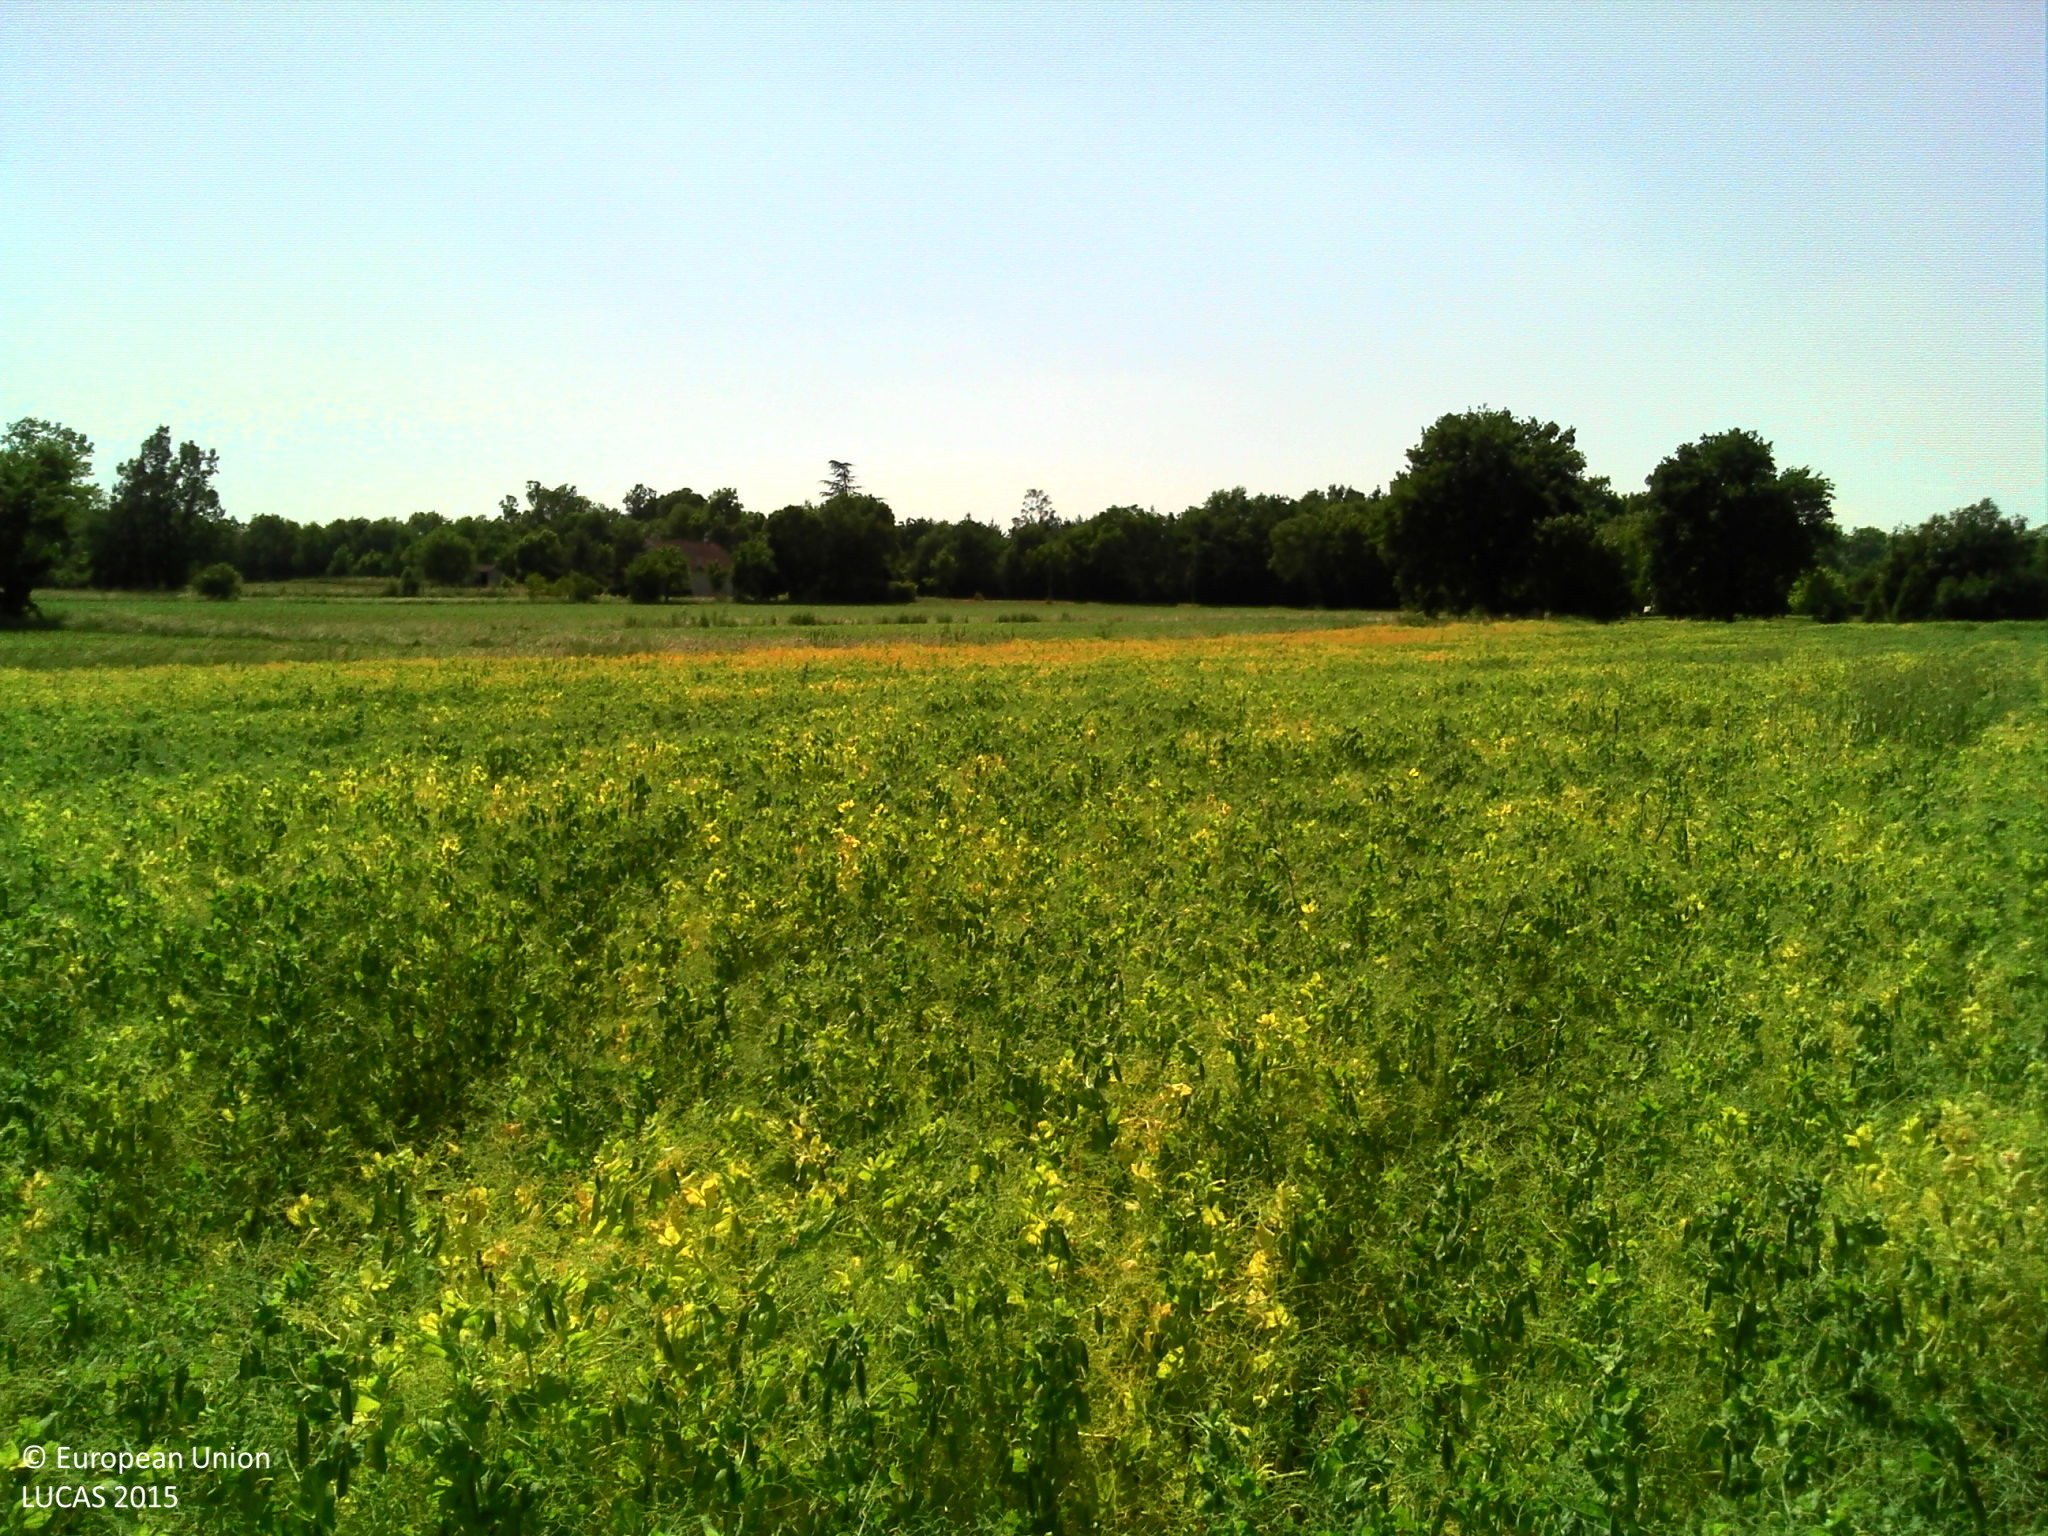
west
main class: Cropland
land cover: Dry pulses
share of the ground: > 75 %
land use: Agriculture (excluding fallow land and kitchen gardens)
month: June
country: FR
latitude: 43.8196
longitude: 0.6597
